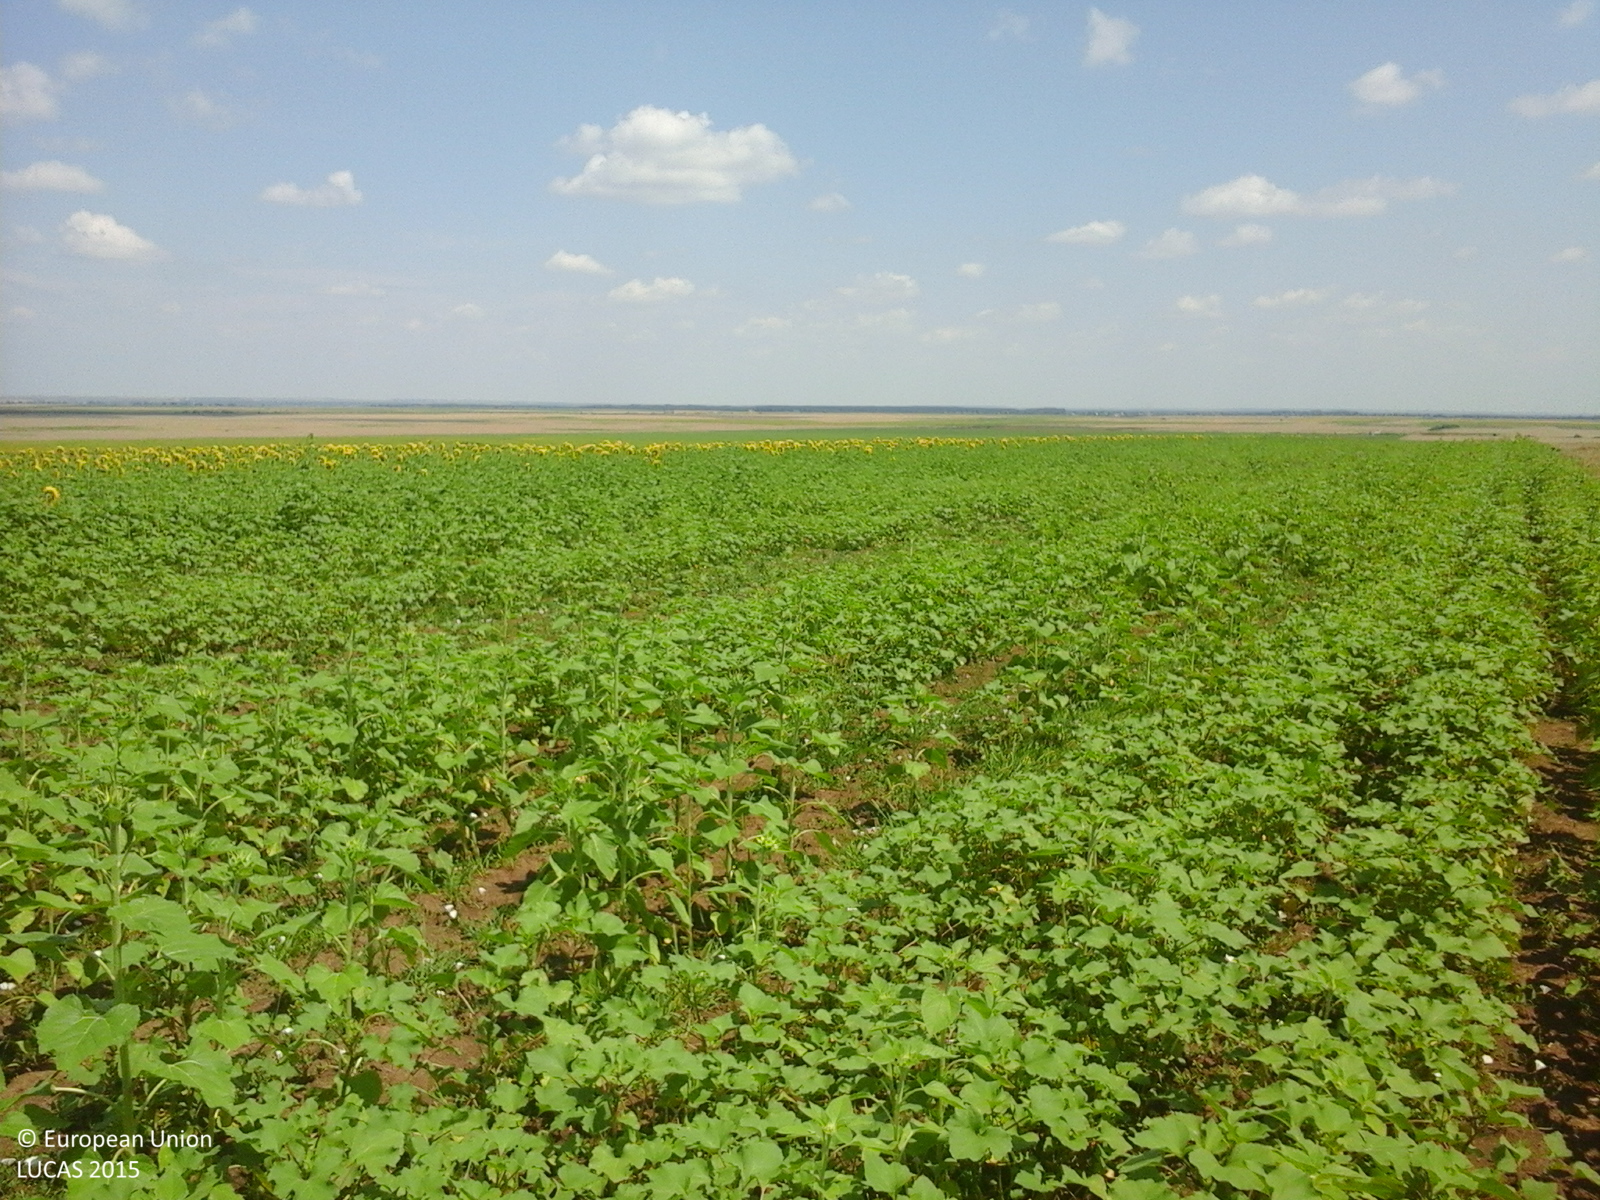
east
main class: Cropland
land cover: Sunflower
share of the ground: 25 - 50 %
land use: Agriculture (excluding fallow land and kitchen gardens)
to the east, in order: Sunflower; Common wheat
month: July
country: RO
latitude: 44.1970
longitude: 24.2909
